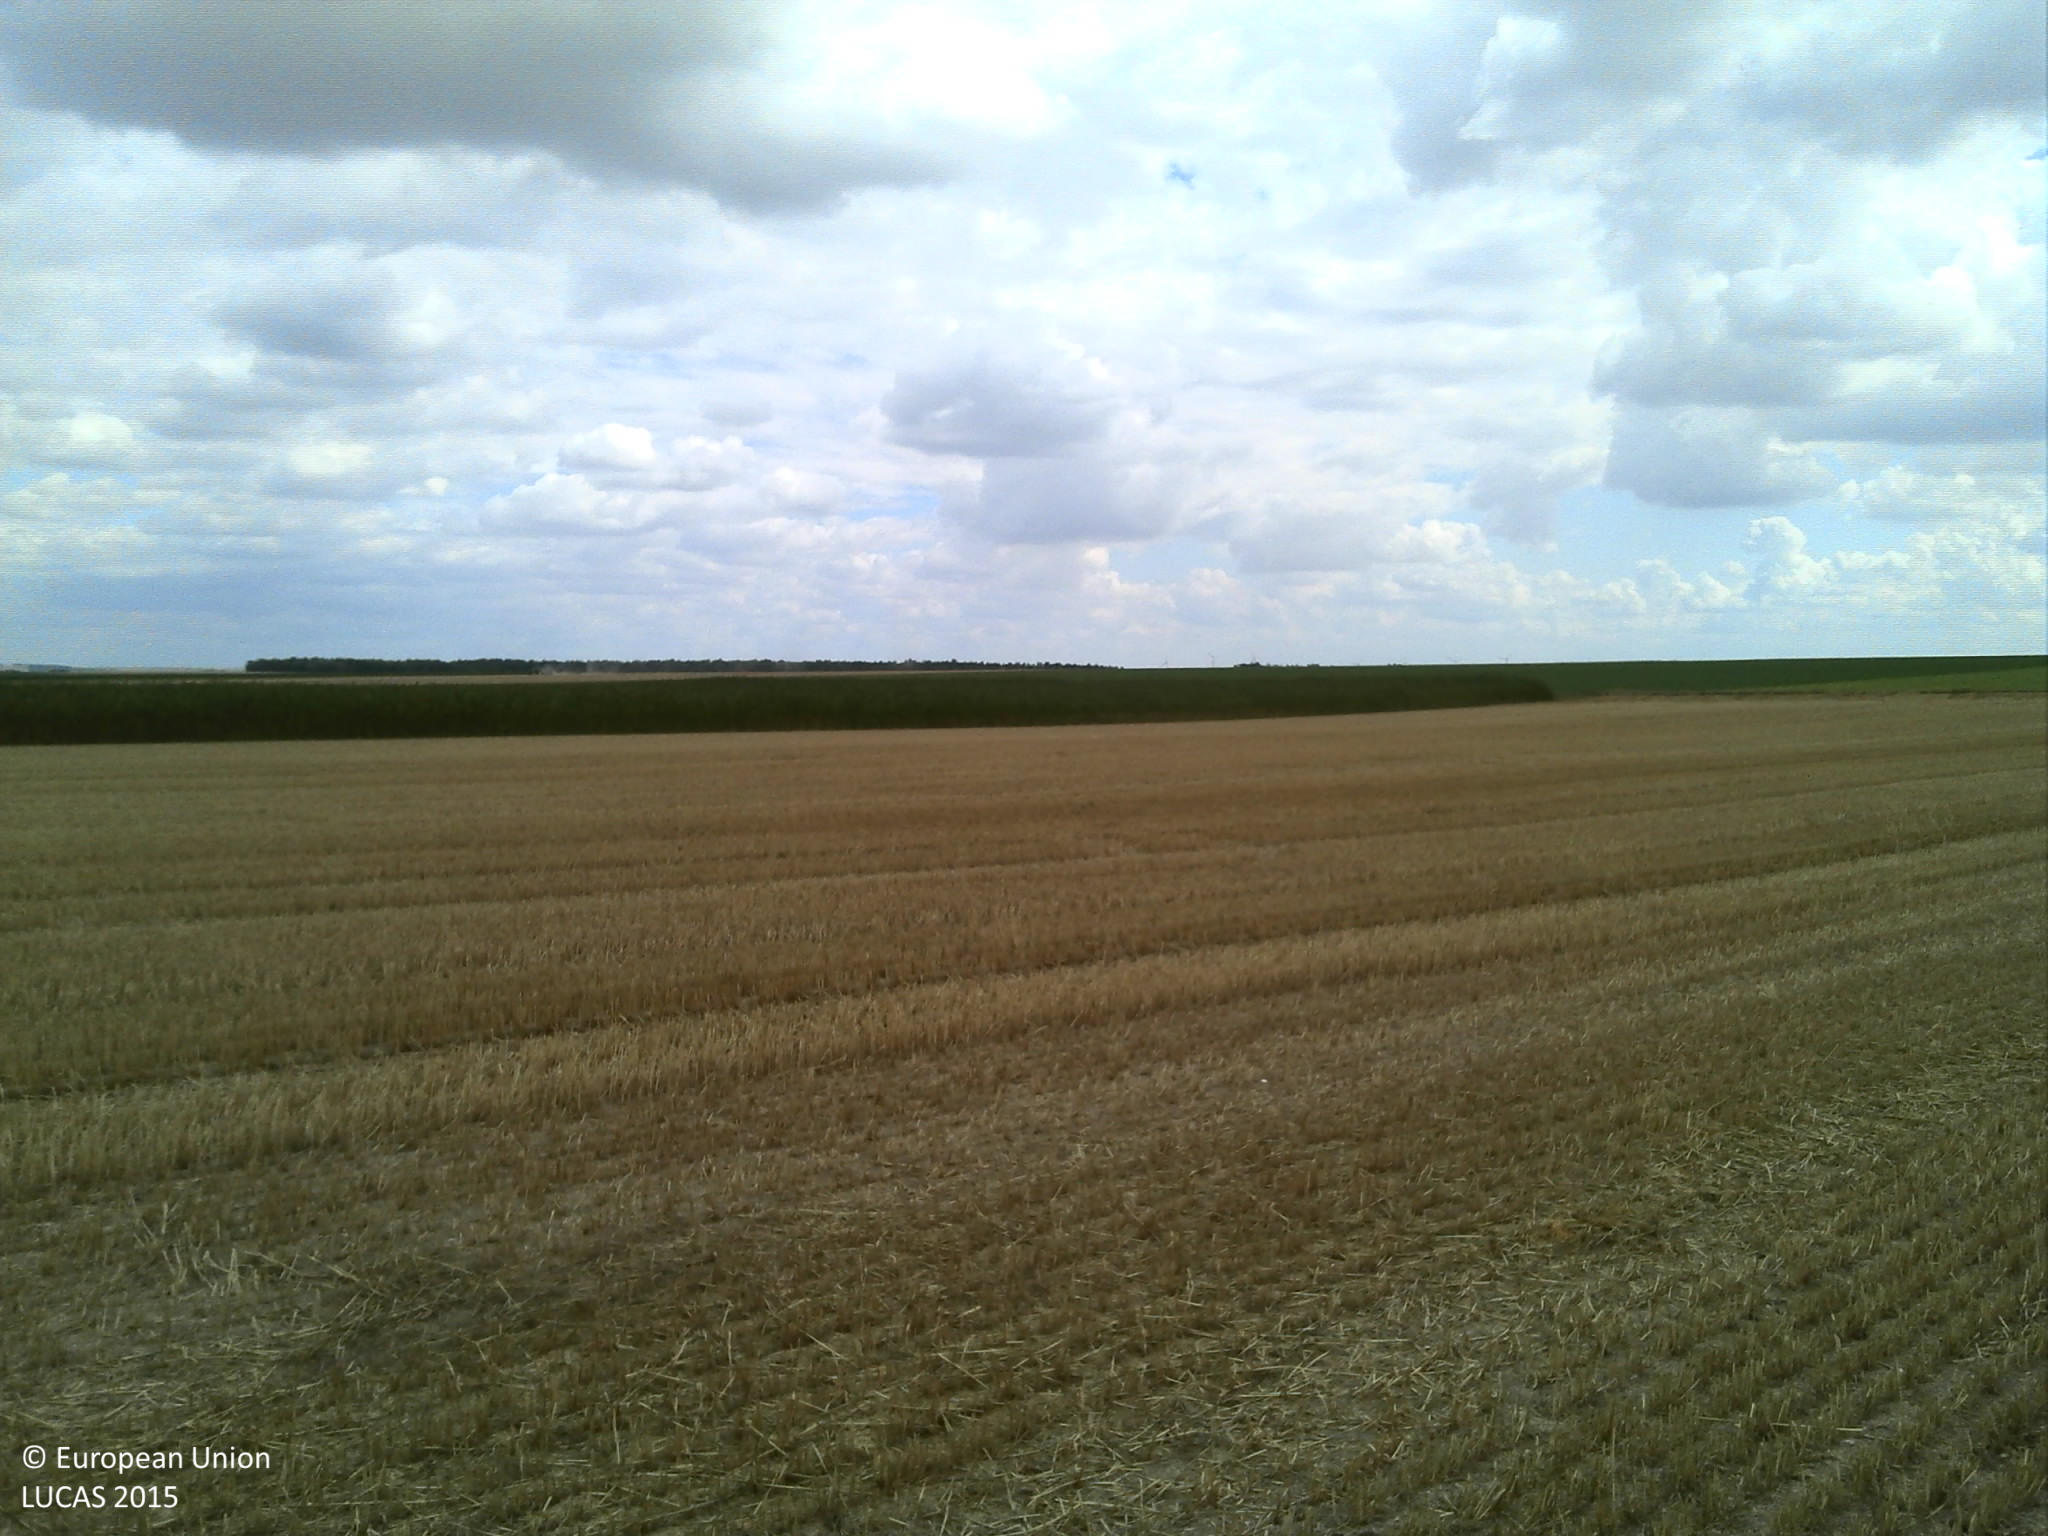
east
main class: Cropland
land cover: Common wheat
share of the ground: > 75 %
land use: Agriculture (excluding fallow land and kitchen gardens)
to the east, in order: Common wheat; Other fibre and oleaginous crops; Grass margins; Tracks; Grass margins; Lucerne; Sugar beet
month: August
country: FR
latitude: 48.4111
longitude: 3.8212
